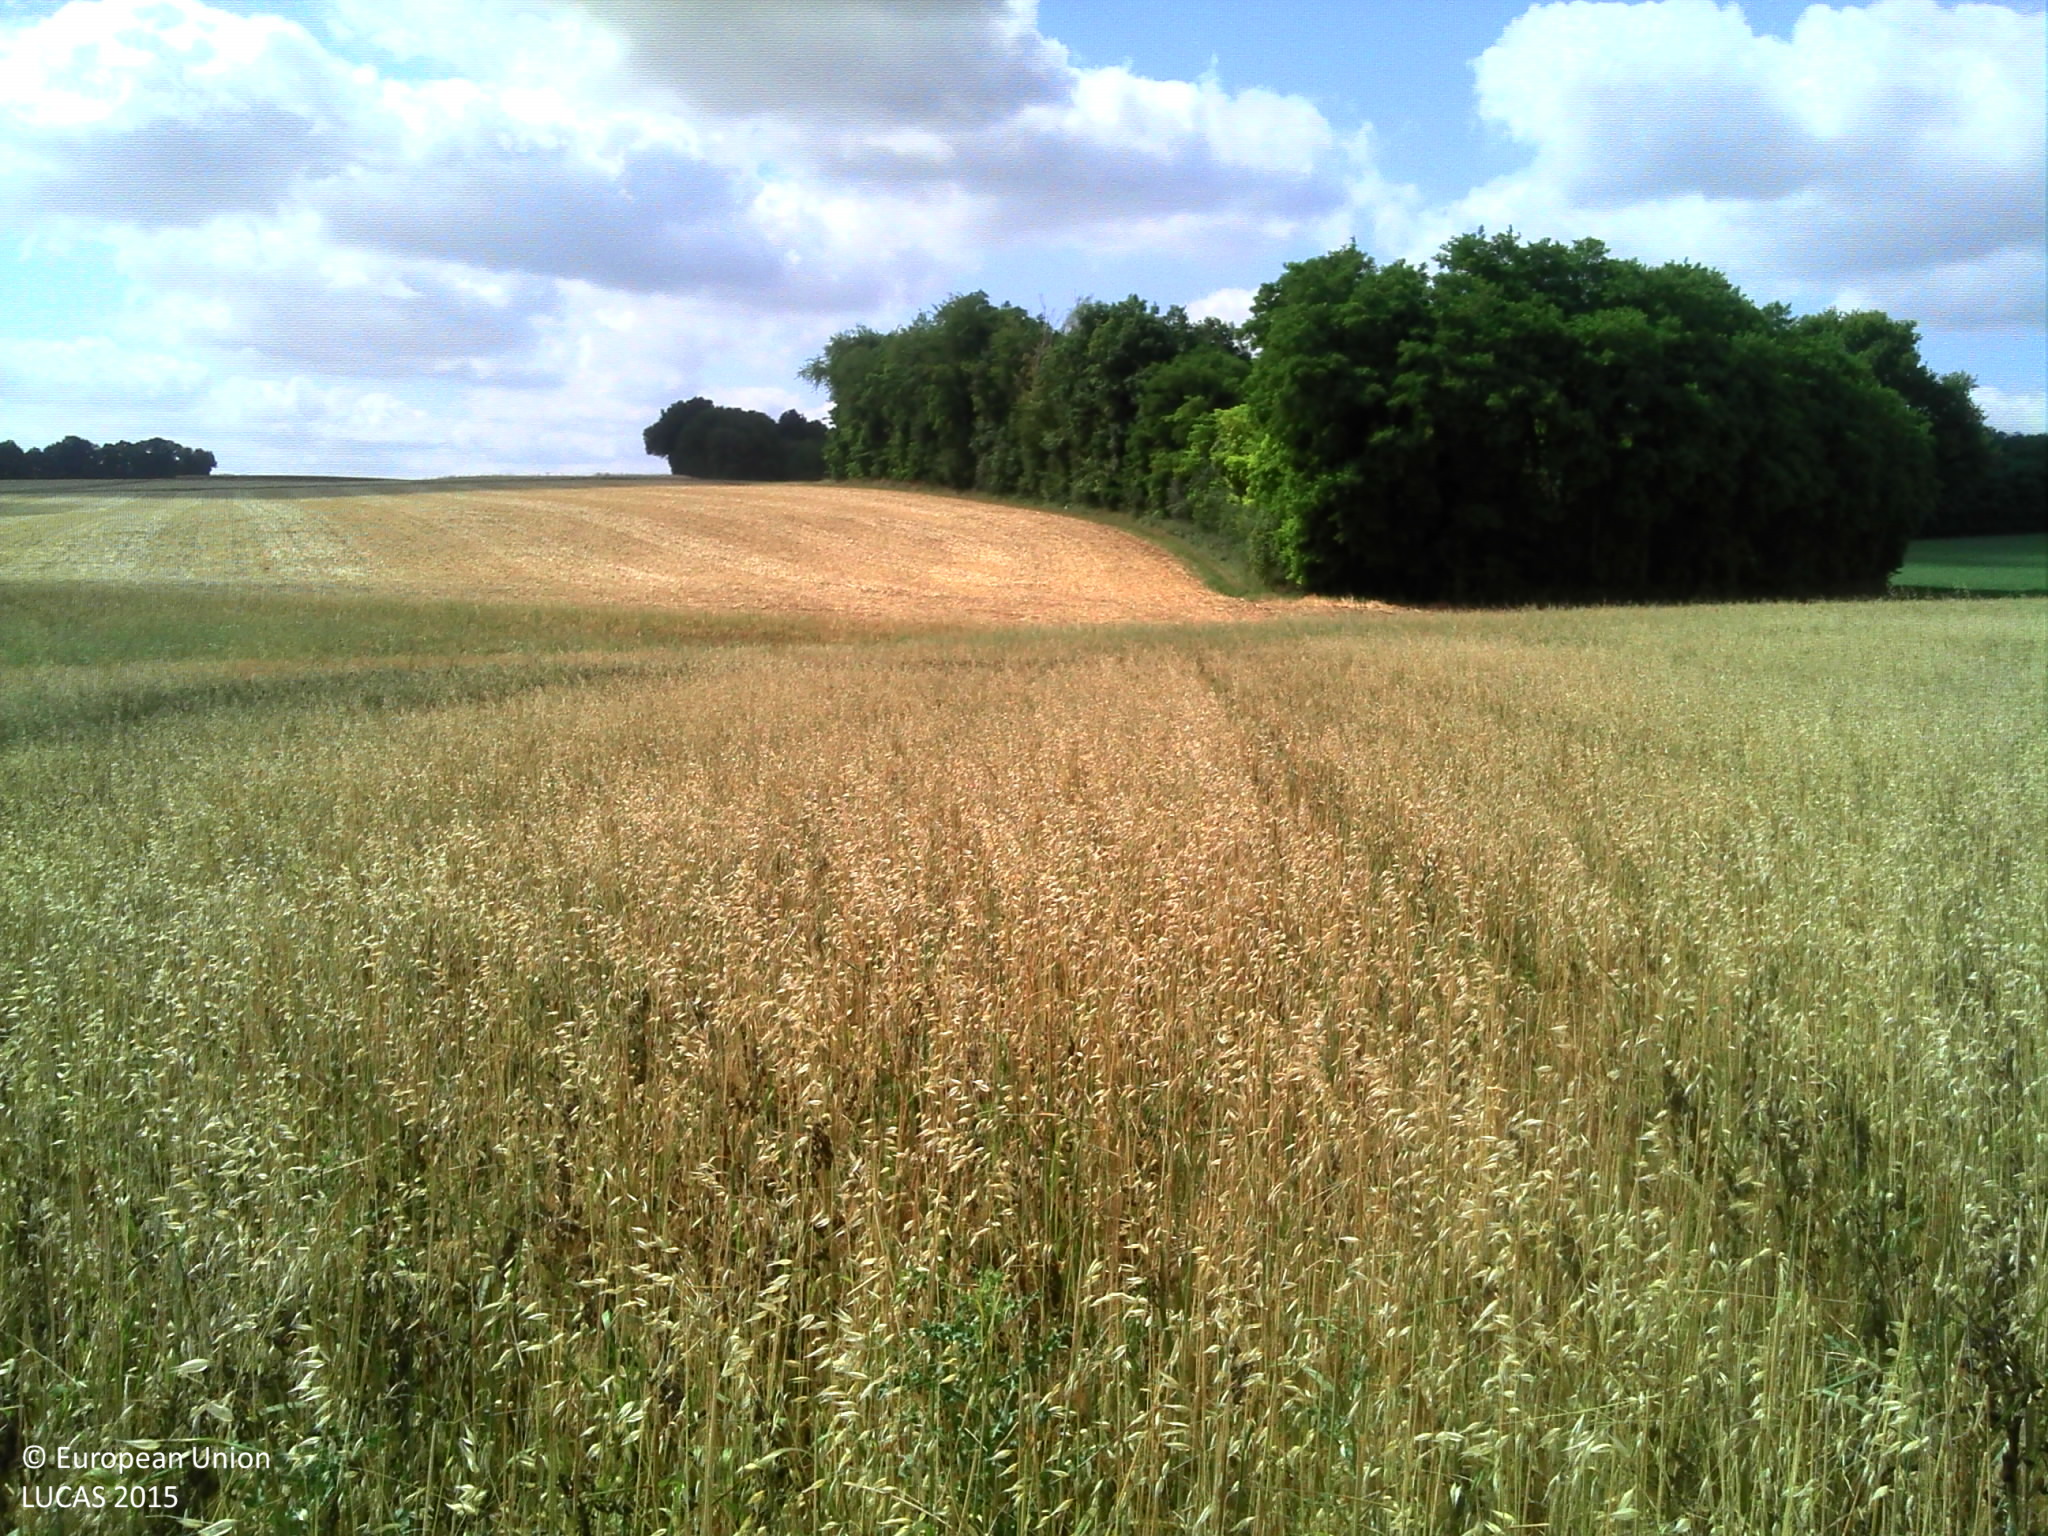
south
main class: Cropland
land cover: Mixed cereals for fodder
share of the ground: > 75 %
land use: Agriculture (excluding fallow land and kitchen gardens)
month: July
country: FR
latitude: 48.3309
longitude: 3.3707
